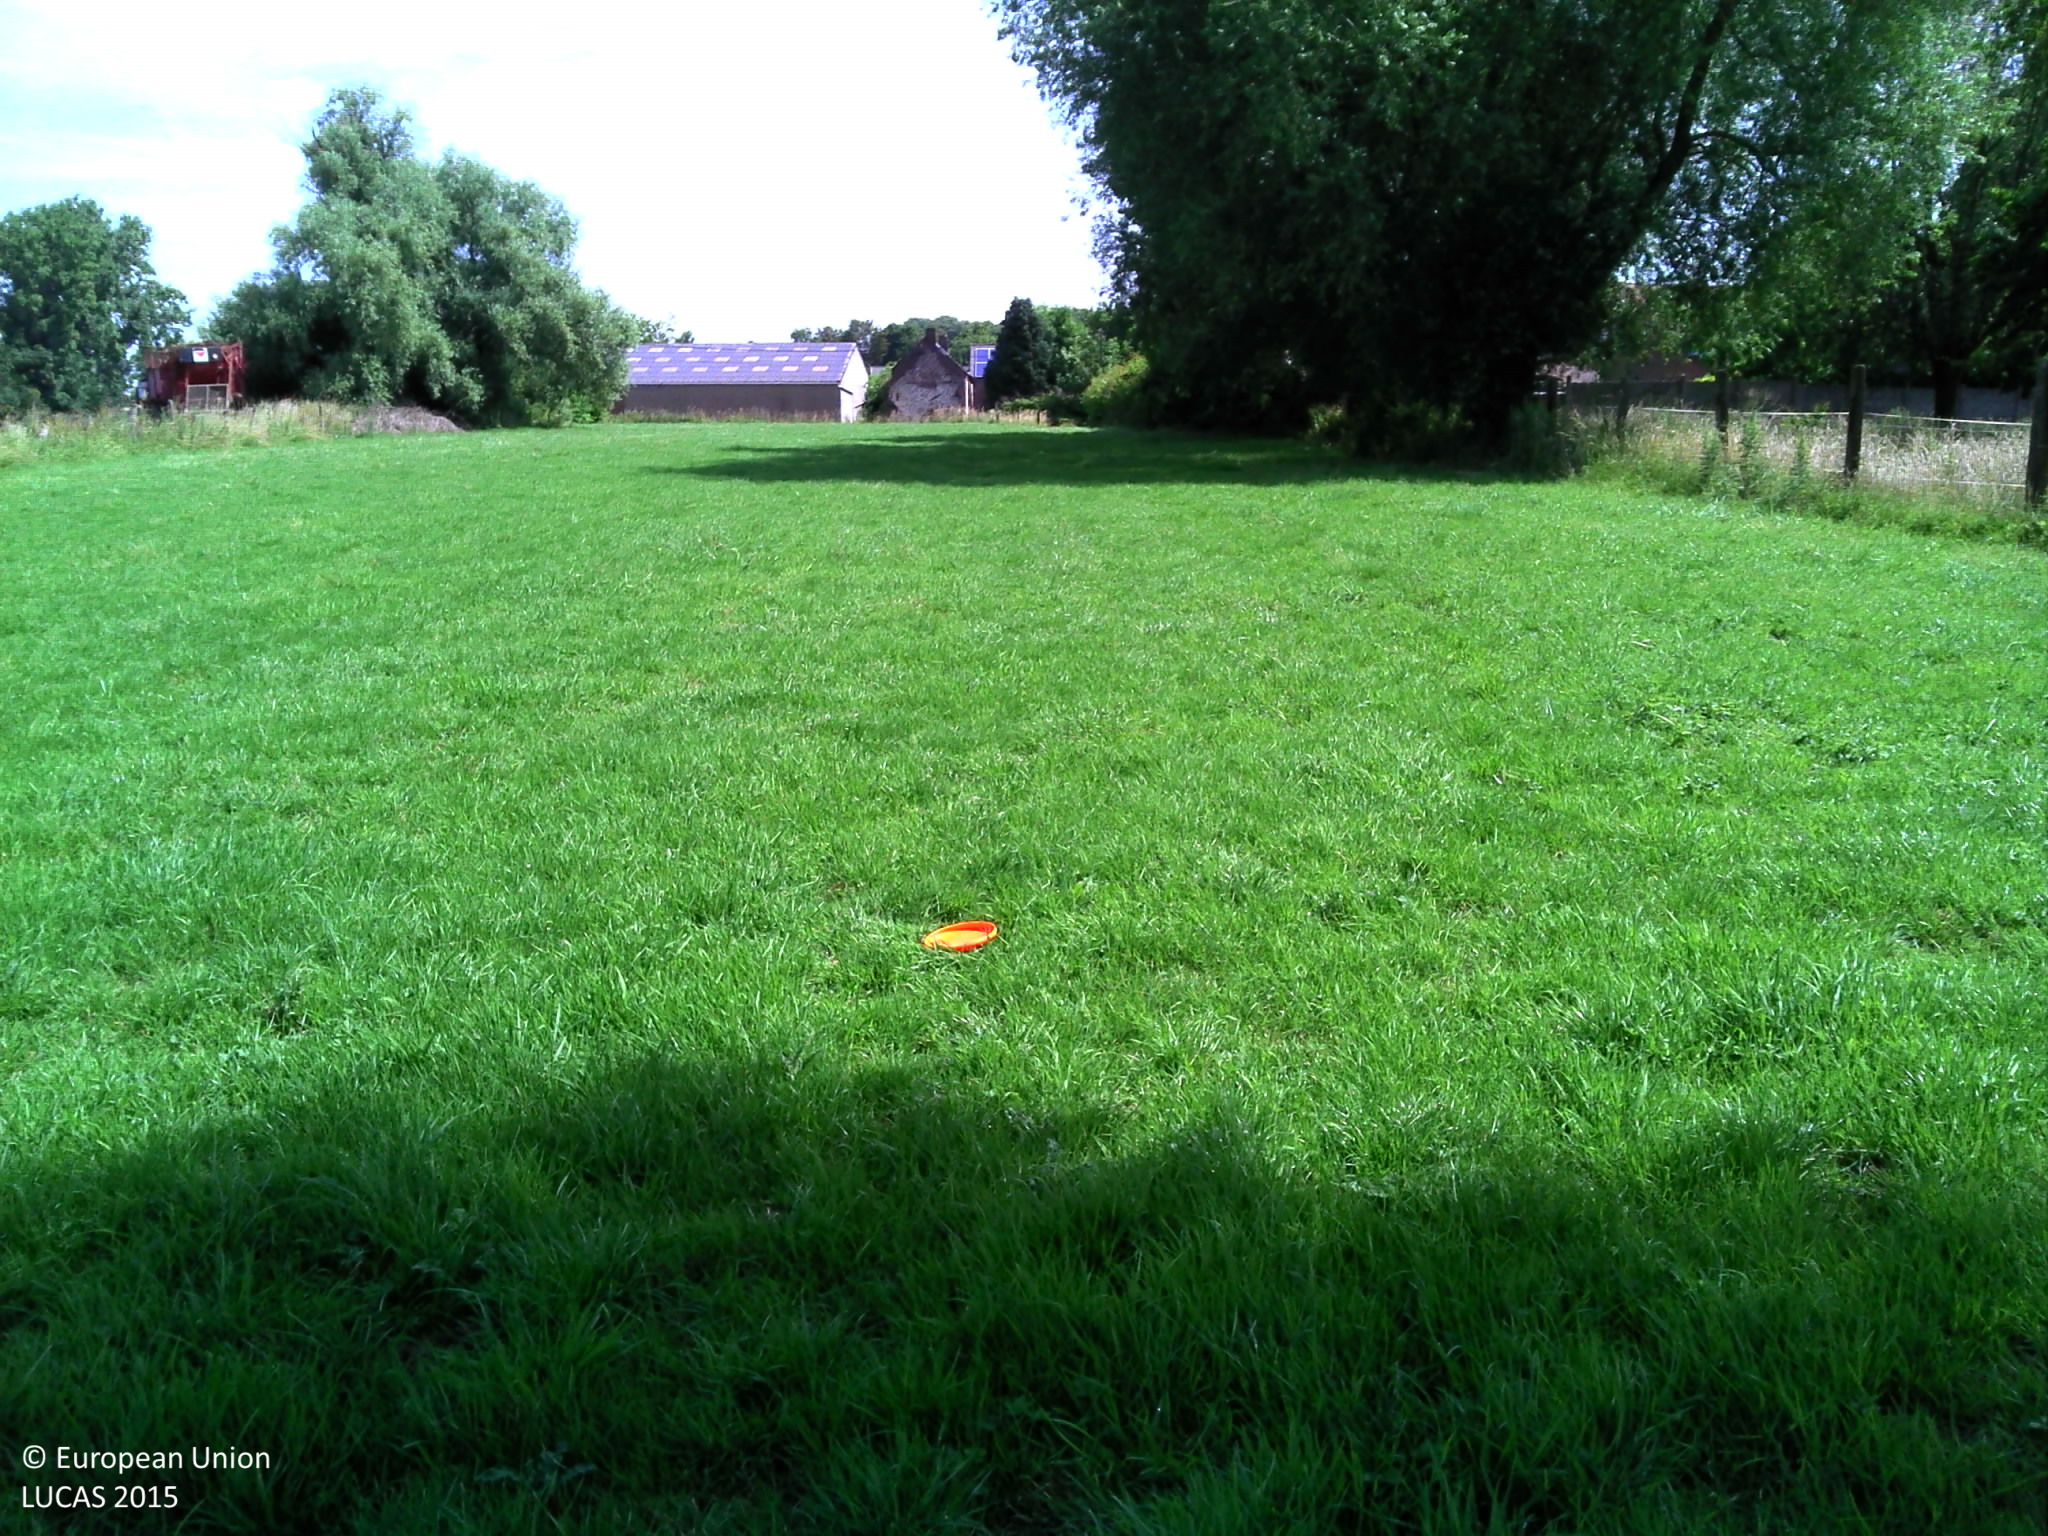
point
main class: Grassland
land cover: Grassland without tree/shrub cover
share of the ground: > 75 %
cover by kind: herbaceous plants 100 %
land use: Agriculture (excluding fallow land and kitchen gardens)
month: June
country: BE
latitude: 50.5456
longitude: 3.6000
